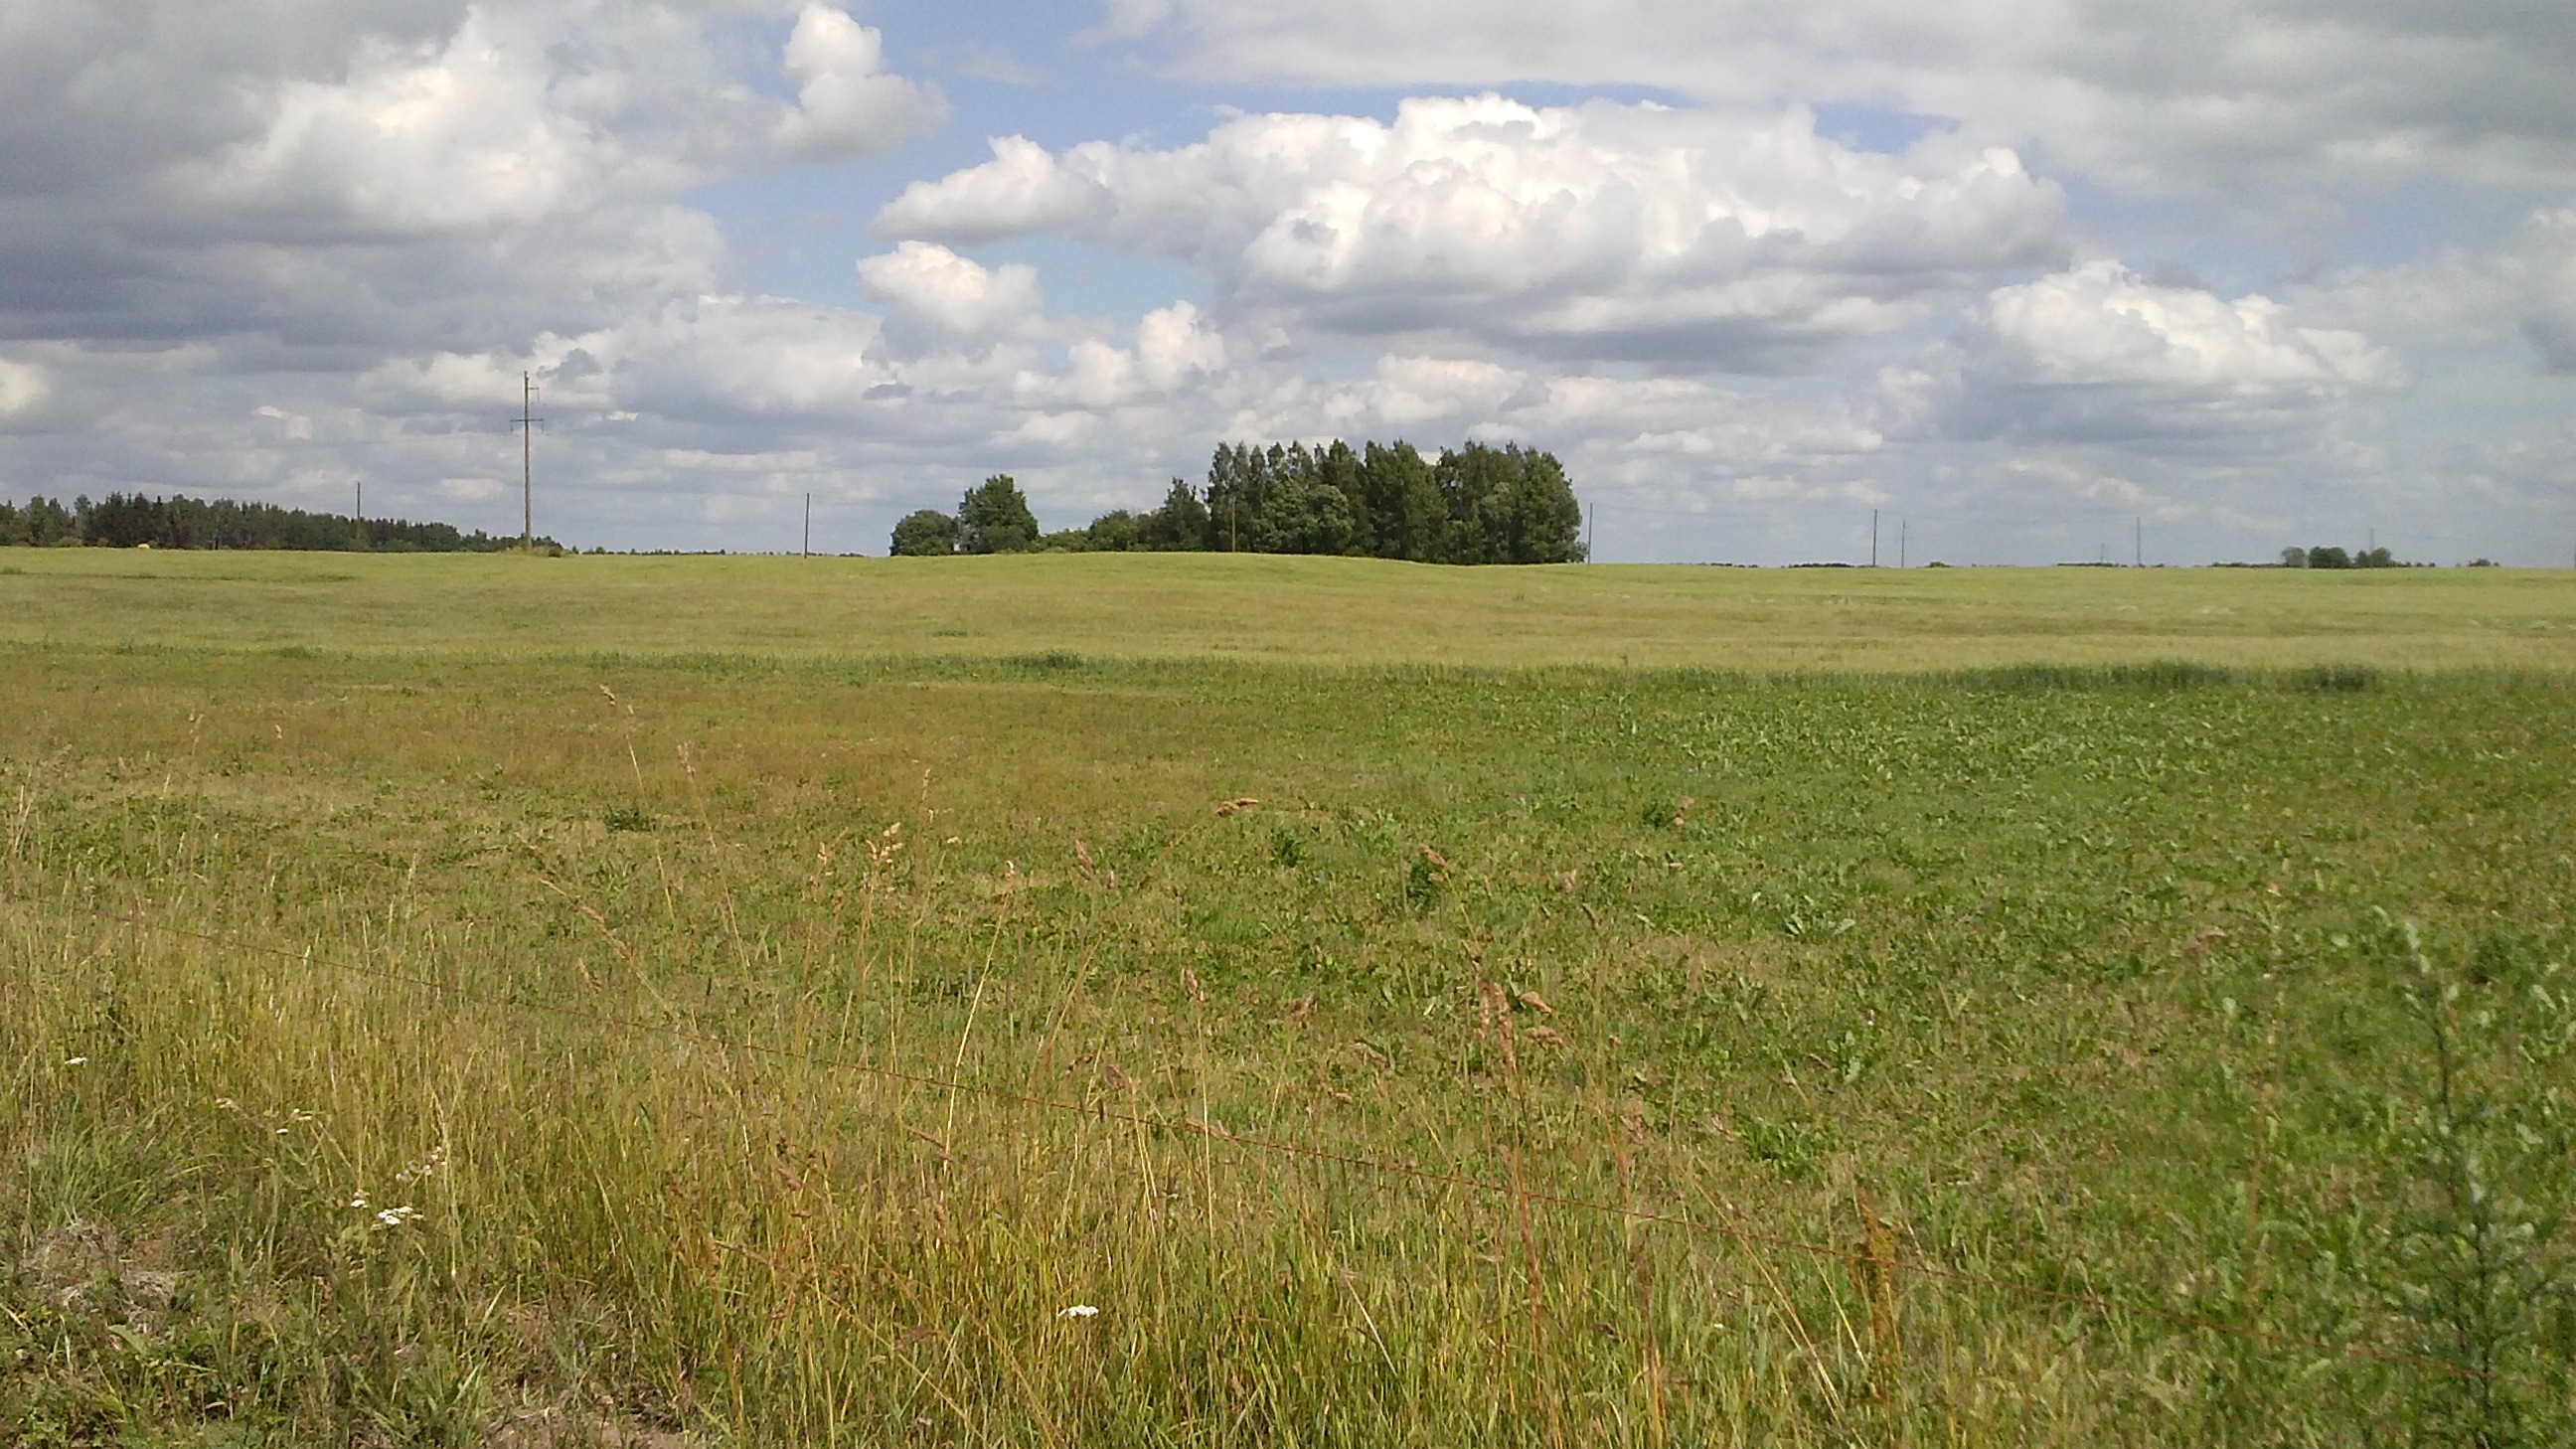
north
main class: Cropland
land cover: Common wheat
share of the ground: > 75 %
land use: Agriculture (excluding fallow land and kitchen gardens)
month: July
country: LV
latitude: 56.4866
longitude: 26.9367
